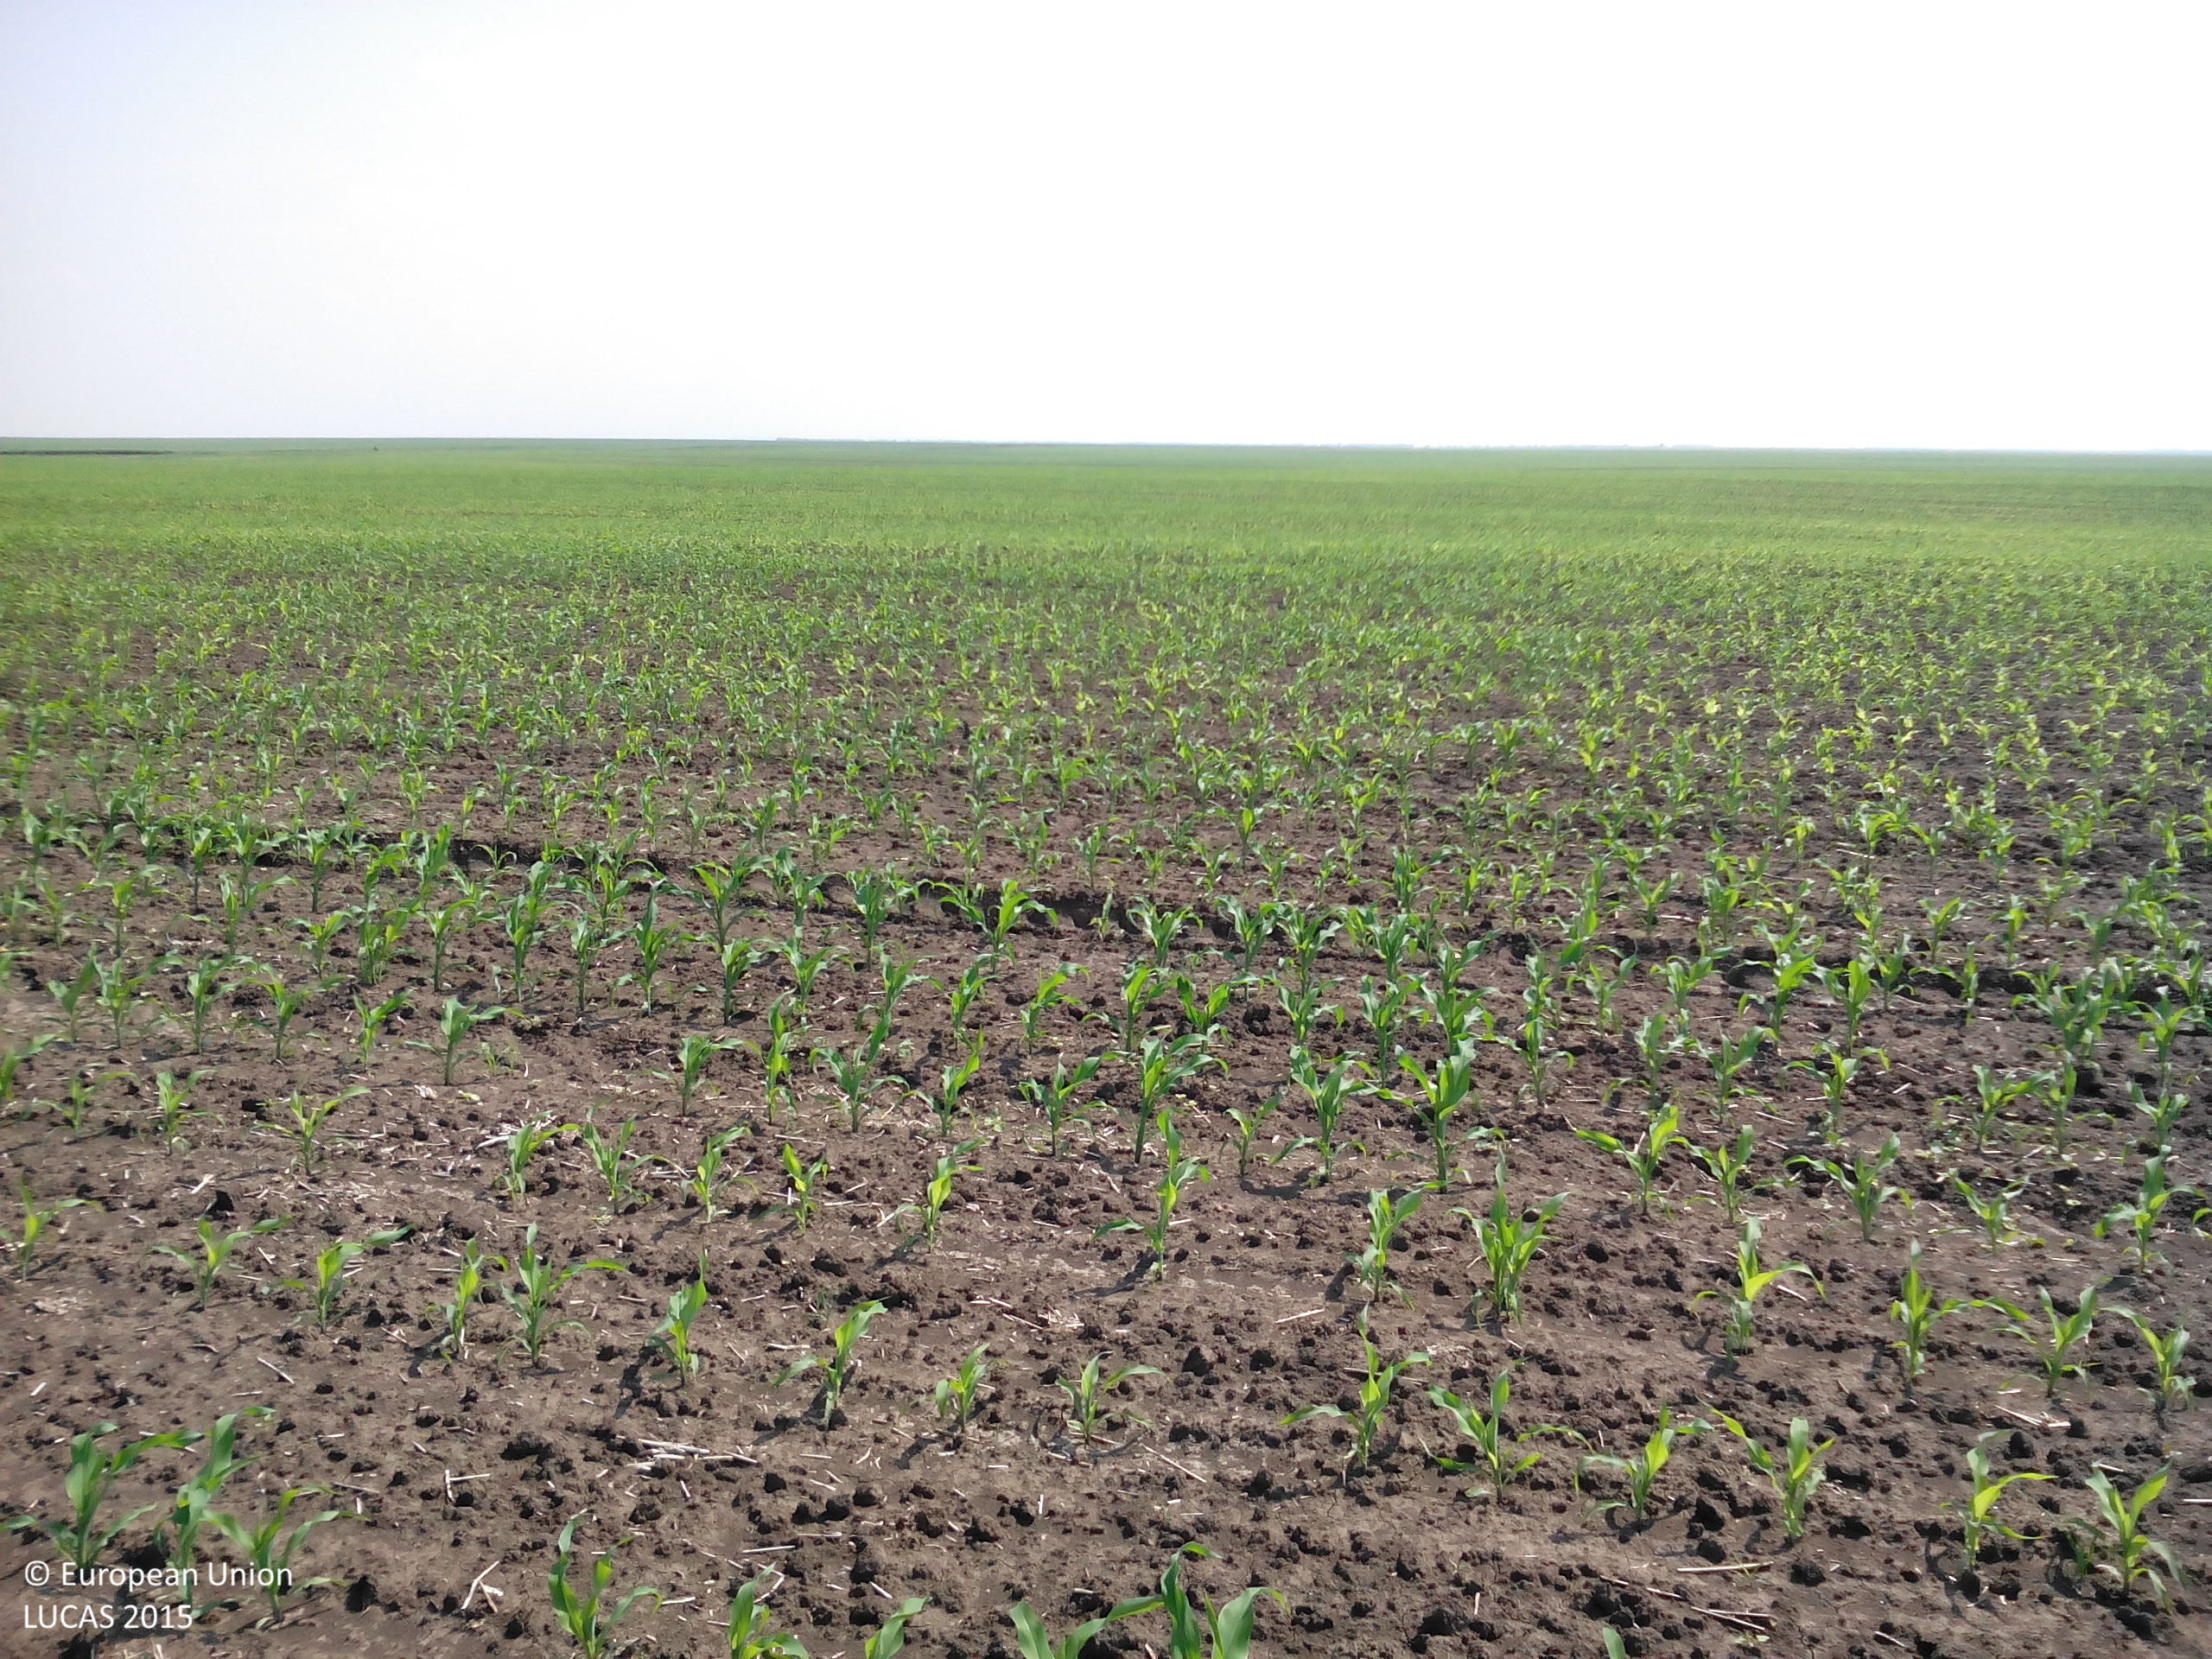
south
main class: Cropland
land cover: Maize
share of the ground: 10 - 25 %
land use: Agriculture (excluding fallow land and kitchen gardens)
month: May
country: BG
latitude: 43.6348
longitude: 24.1246
